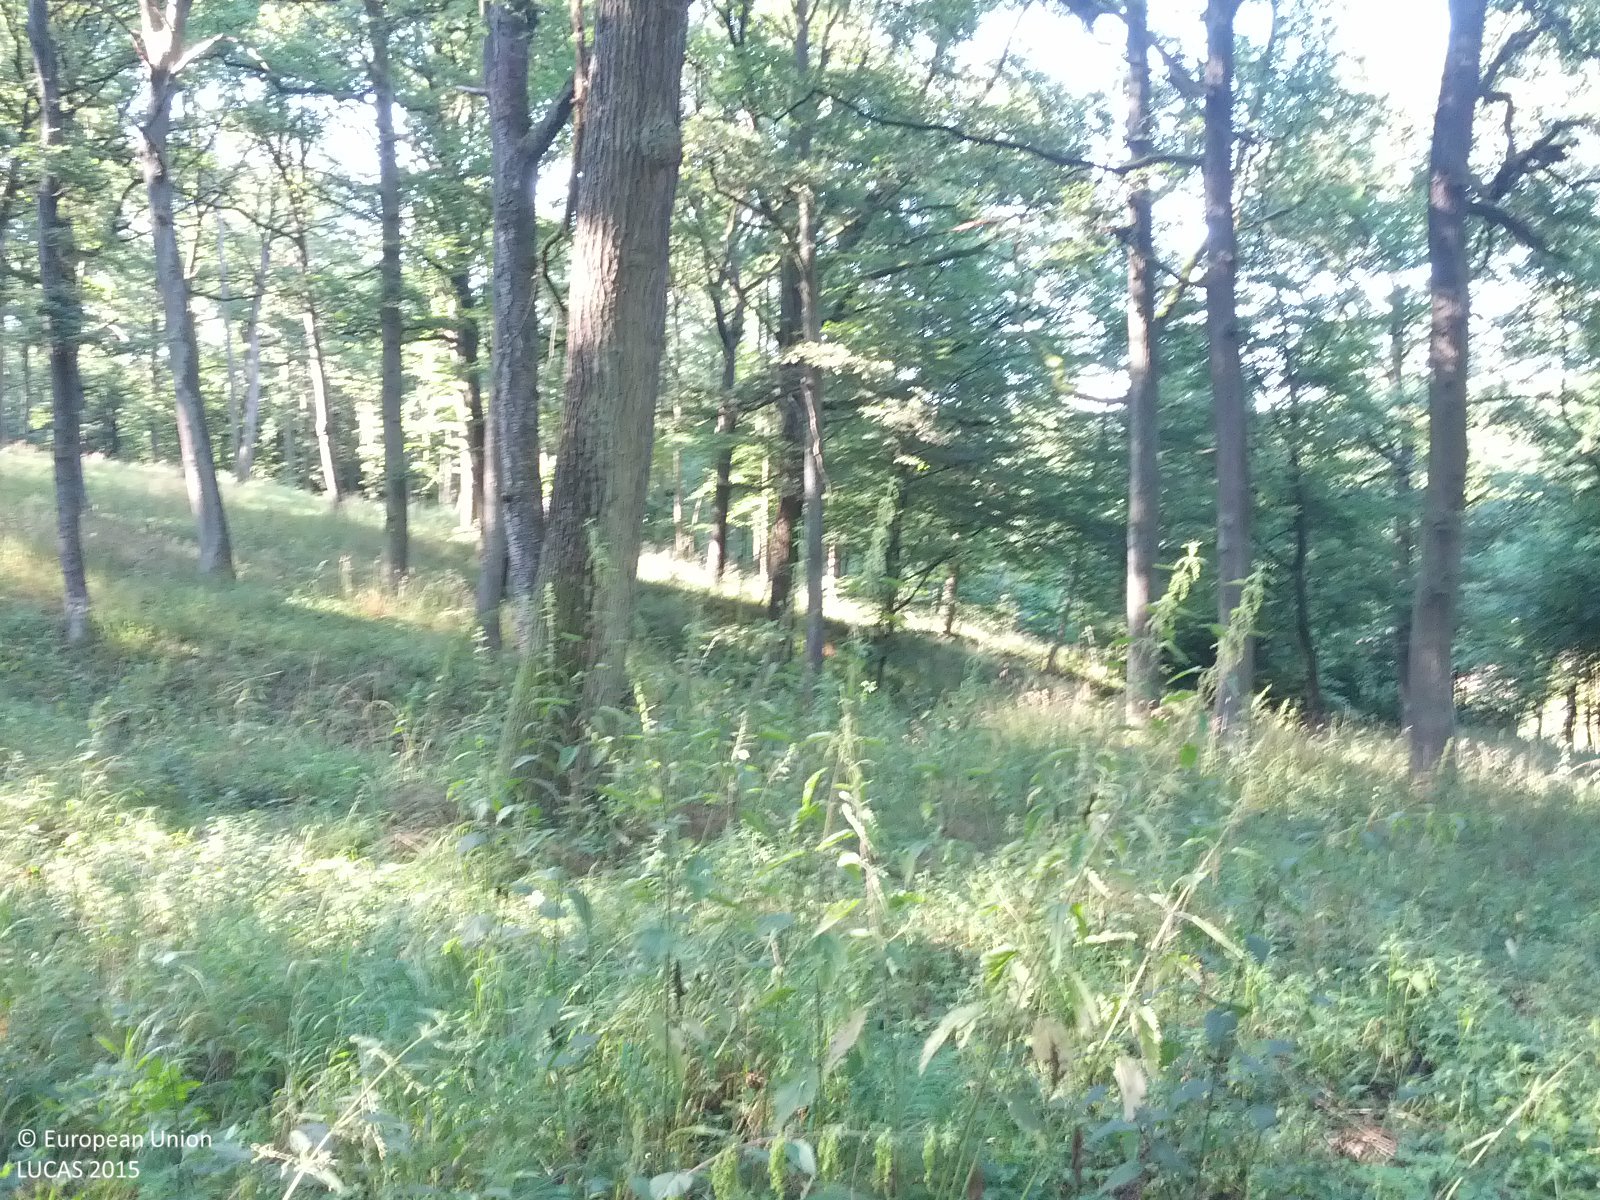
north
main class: Woodland
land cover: Broadleaved woodland
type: acidophilous oak and oak-birch forest
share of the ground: > 75 %
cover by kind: broadleaved forest trees 80 %, herbaceous plants 20 %
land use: Forestry
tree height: > 5 m
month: July
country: AT
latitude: 48.5499
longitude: 16.2775
